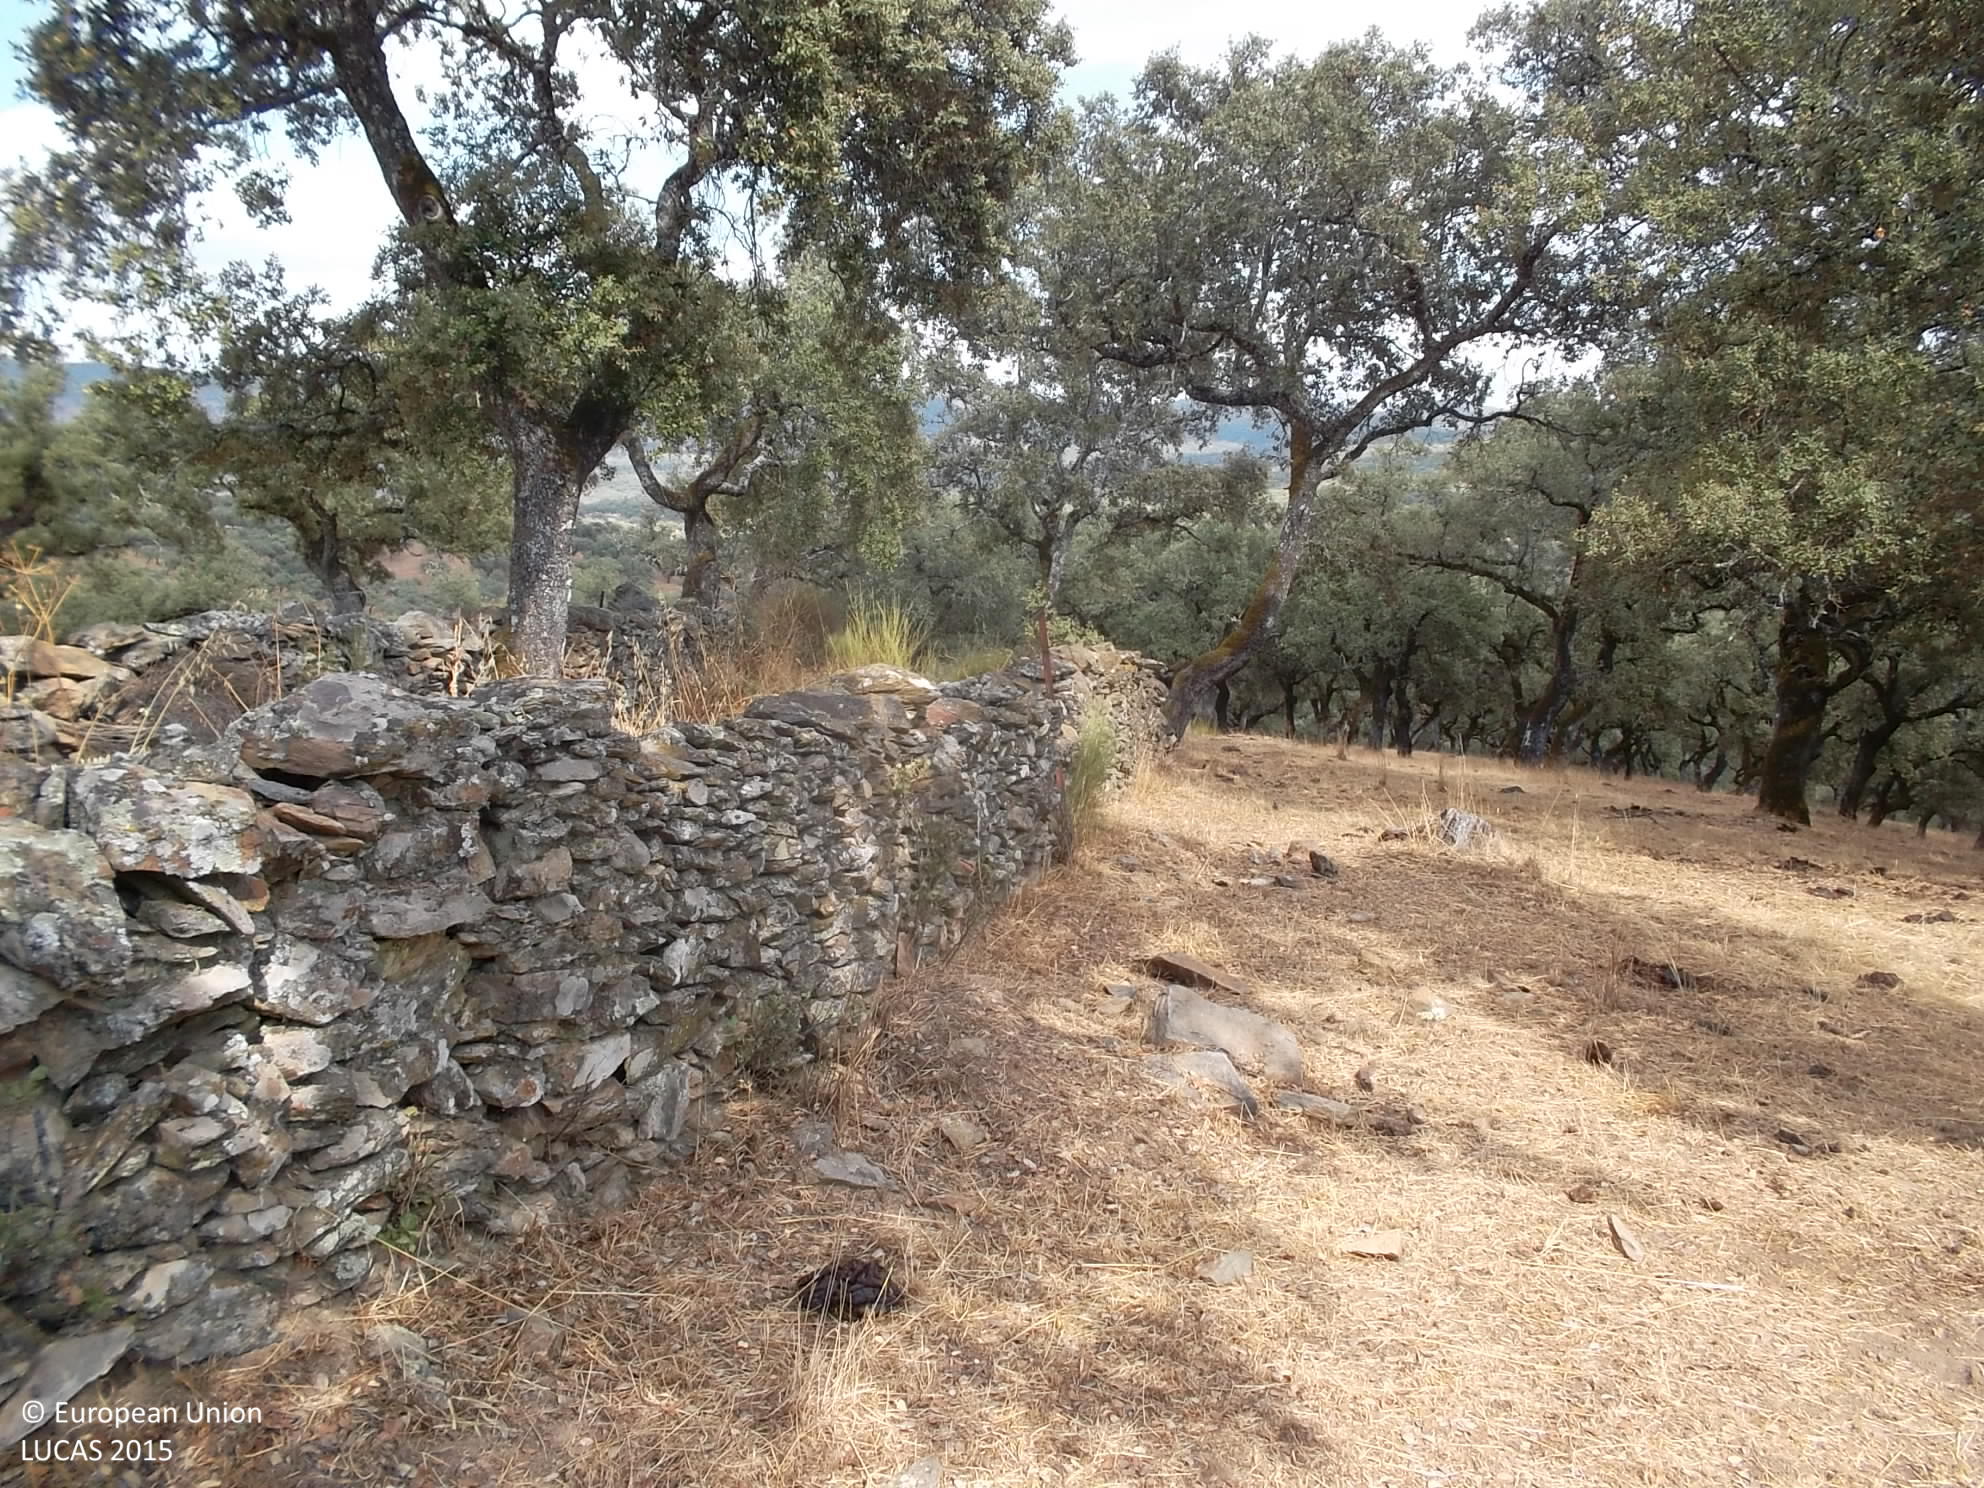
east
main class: Woodland
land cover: Broadleaved woodland
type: broadleaved evergreen forest
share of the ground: 50 - 75 %
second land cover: Grassland without tree/shrub cover
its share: > 75 %
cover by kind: broadleaved forest trees 50 %, herbaceous plants 50 %
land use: Forestry
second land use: Agriculture (excluding fallow land and kitchen gardens)
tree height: > 5 m
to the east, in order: Broadleaved woodland; Grassland without tree/shrub cover; Dry stone walls; Broadleaved woodland
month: September
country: ES
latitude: 38.0503
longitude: -6.4890
